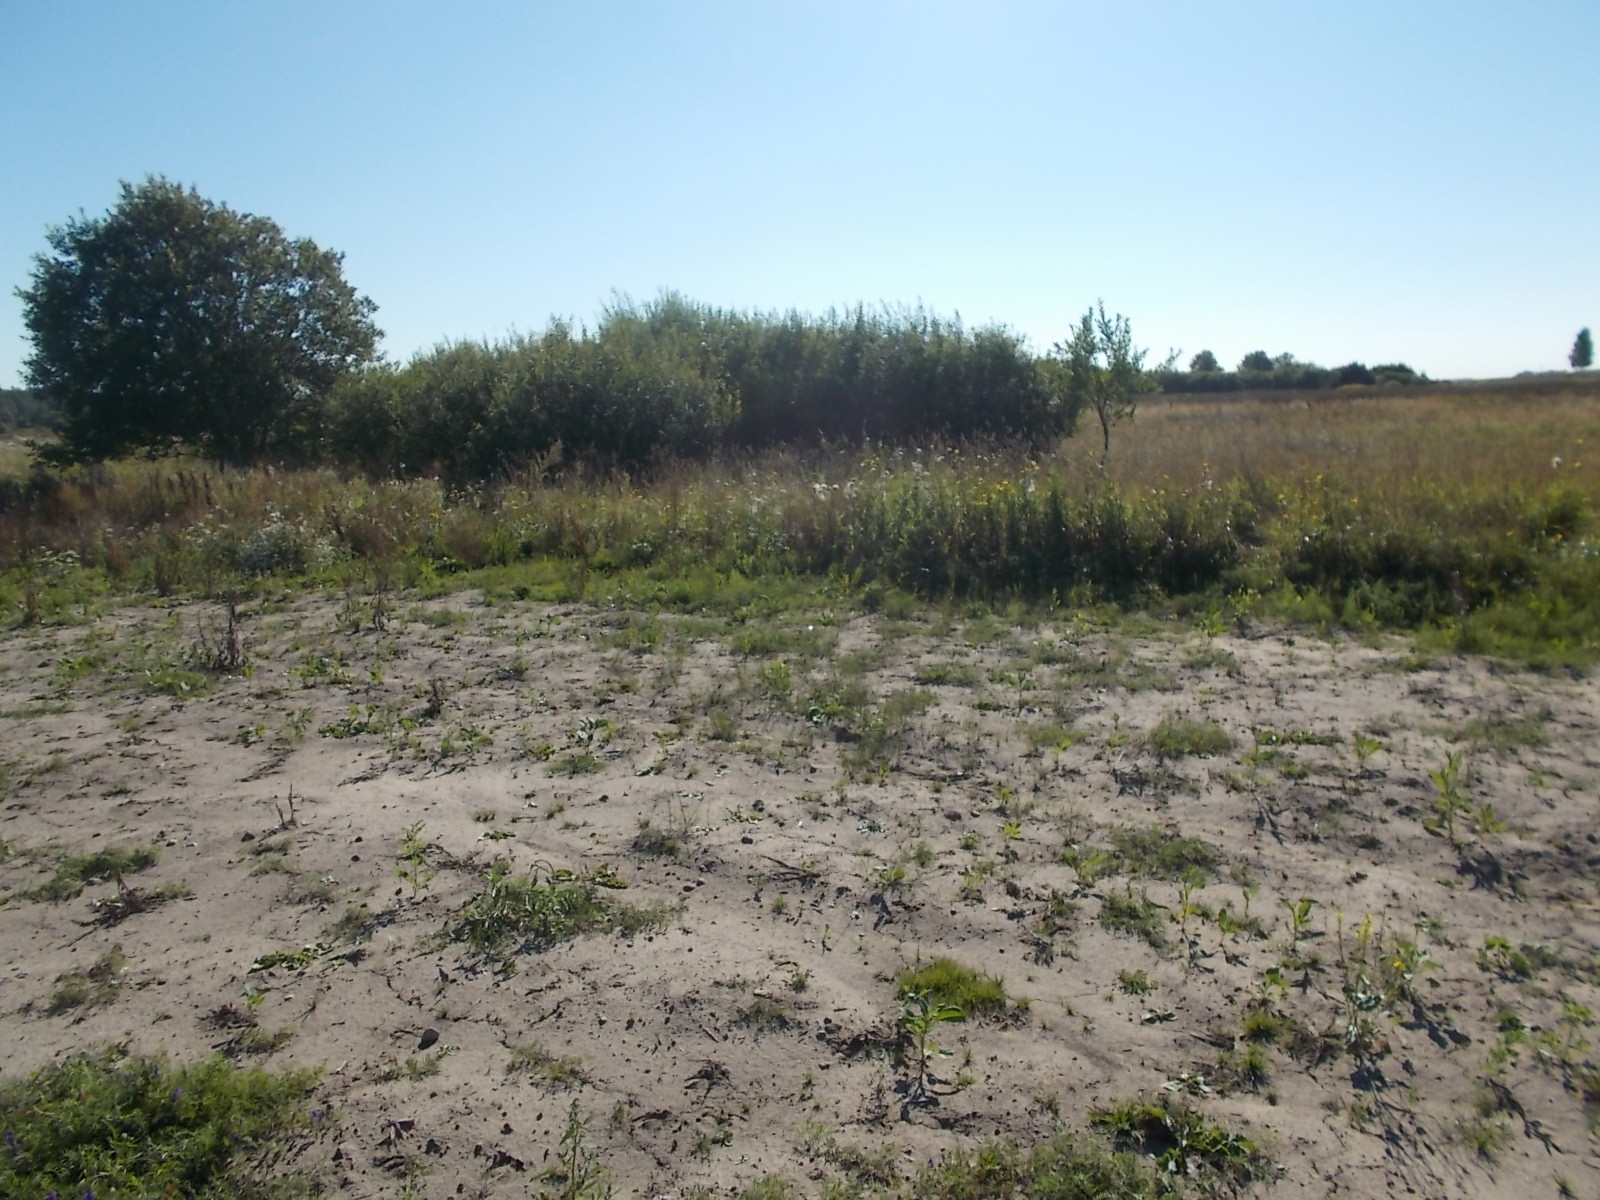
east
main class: Grassland
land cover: Spontaneously vegetated surfaces
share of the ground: 25 - 50 %
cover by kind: unconsolidated bare surface 55 %, herbaceous plants 45 %
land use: Fallow land
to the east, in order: Spontaneously vegetated surfaces; Electric lines; Spontaneously vegetated surfaces; Abandoned hedges; Ditches and canals; Rape and turnip rape
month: August
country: LV
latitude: 56.9265
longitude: 22.8272
